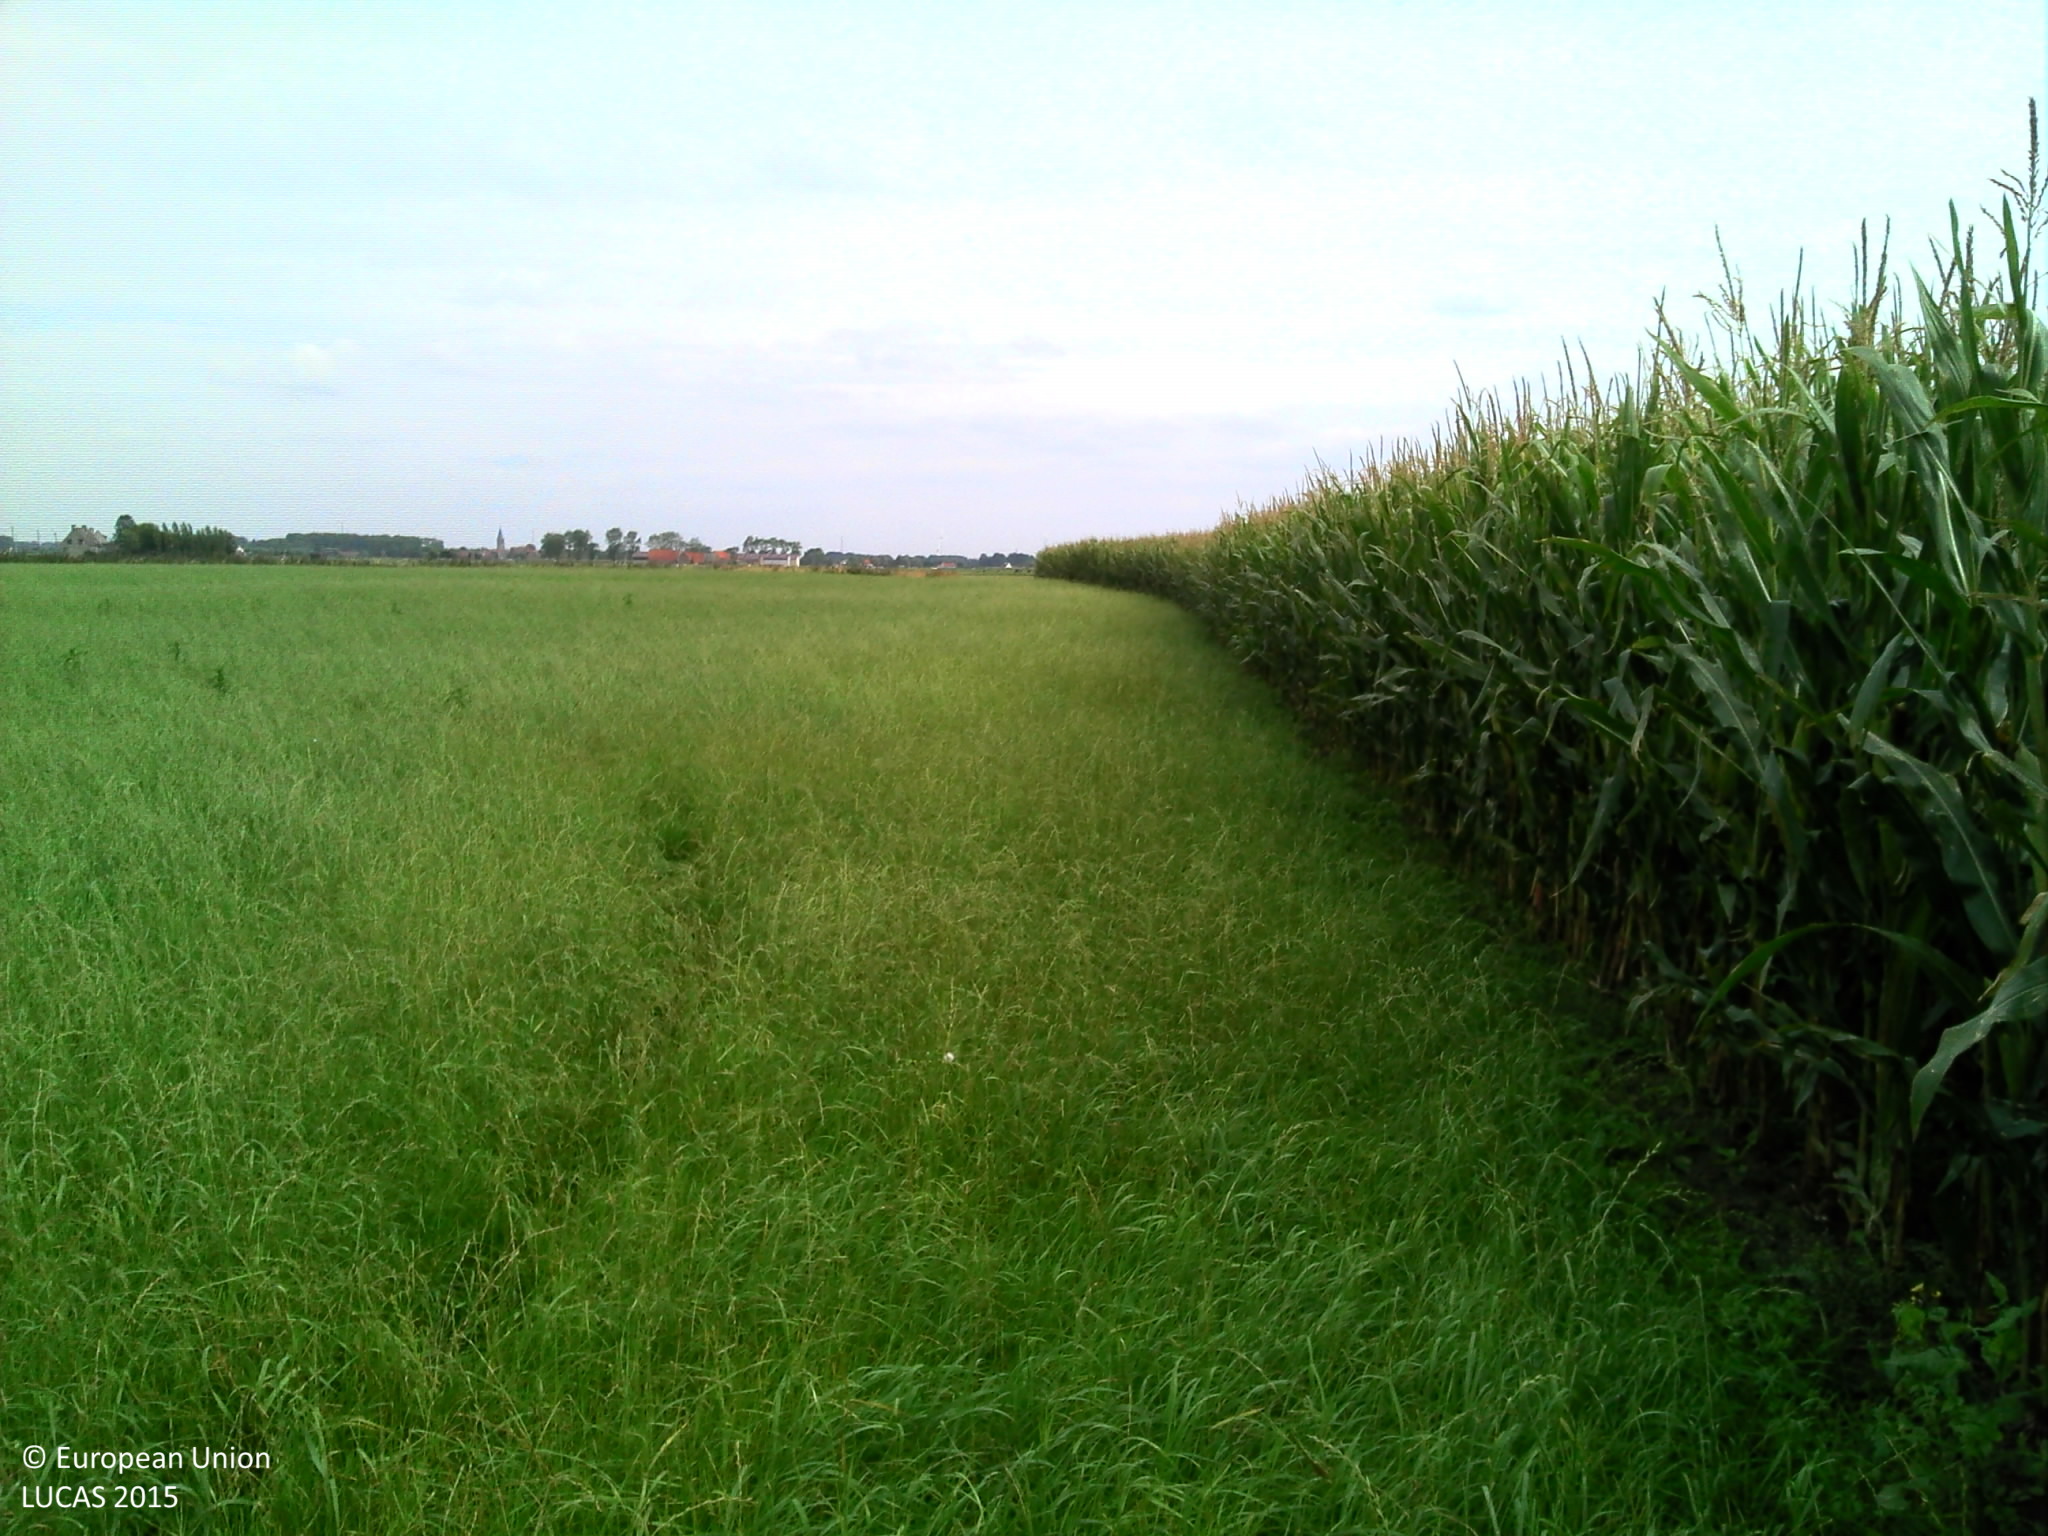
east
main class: Cropland
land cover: Maize
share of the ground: > 75 %
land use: Agriculture (excluding fallow land and kitchen gardens)
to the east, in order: Maize; Common wheat
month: September
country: BE
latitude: 51.2580
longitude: 3.1266
